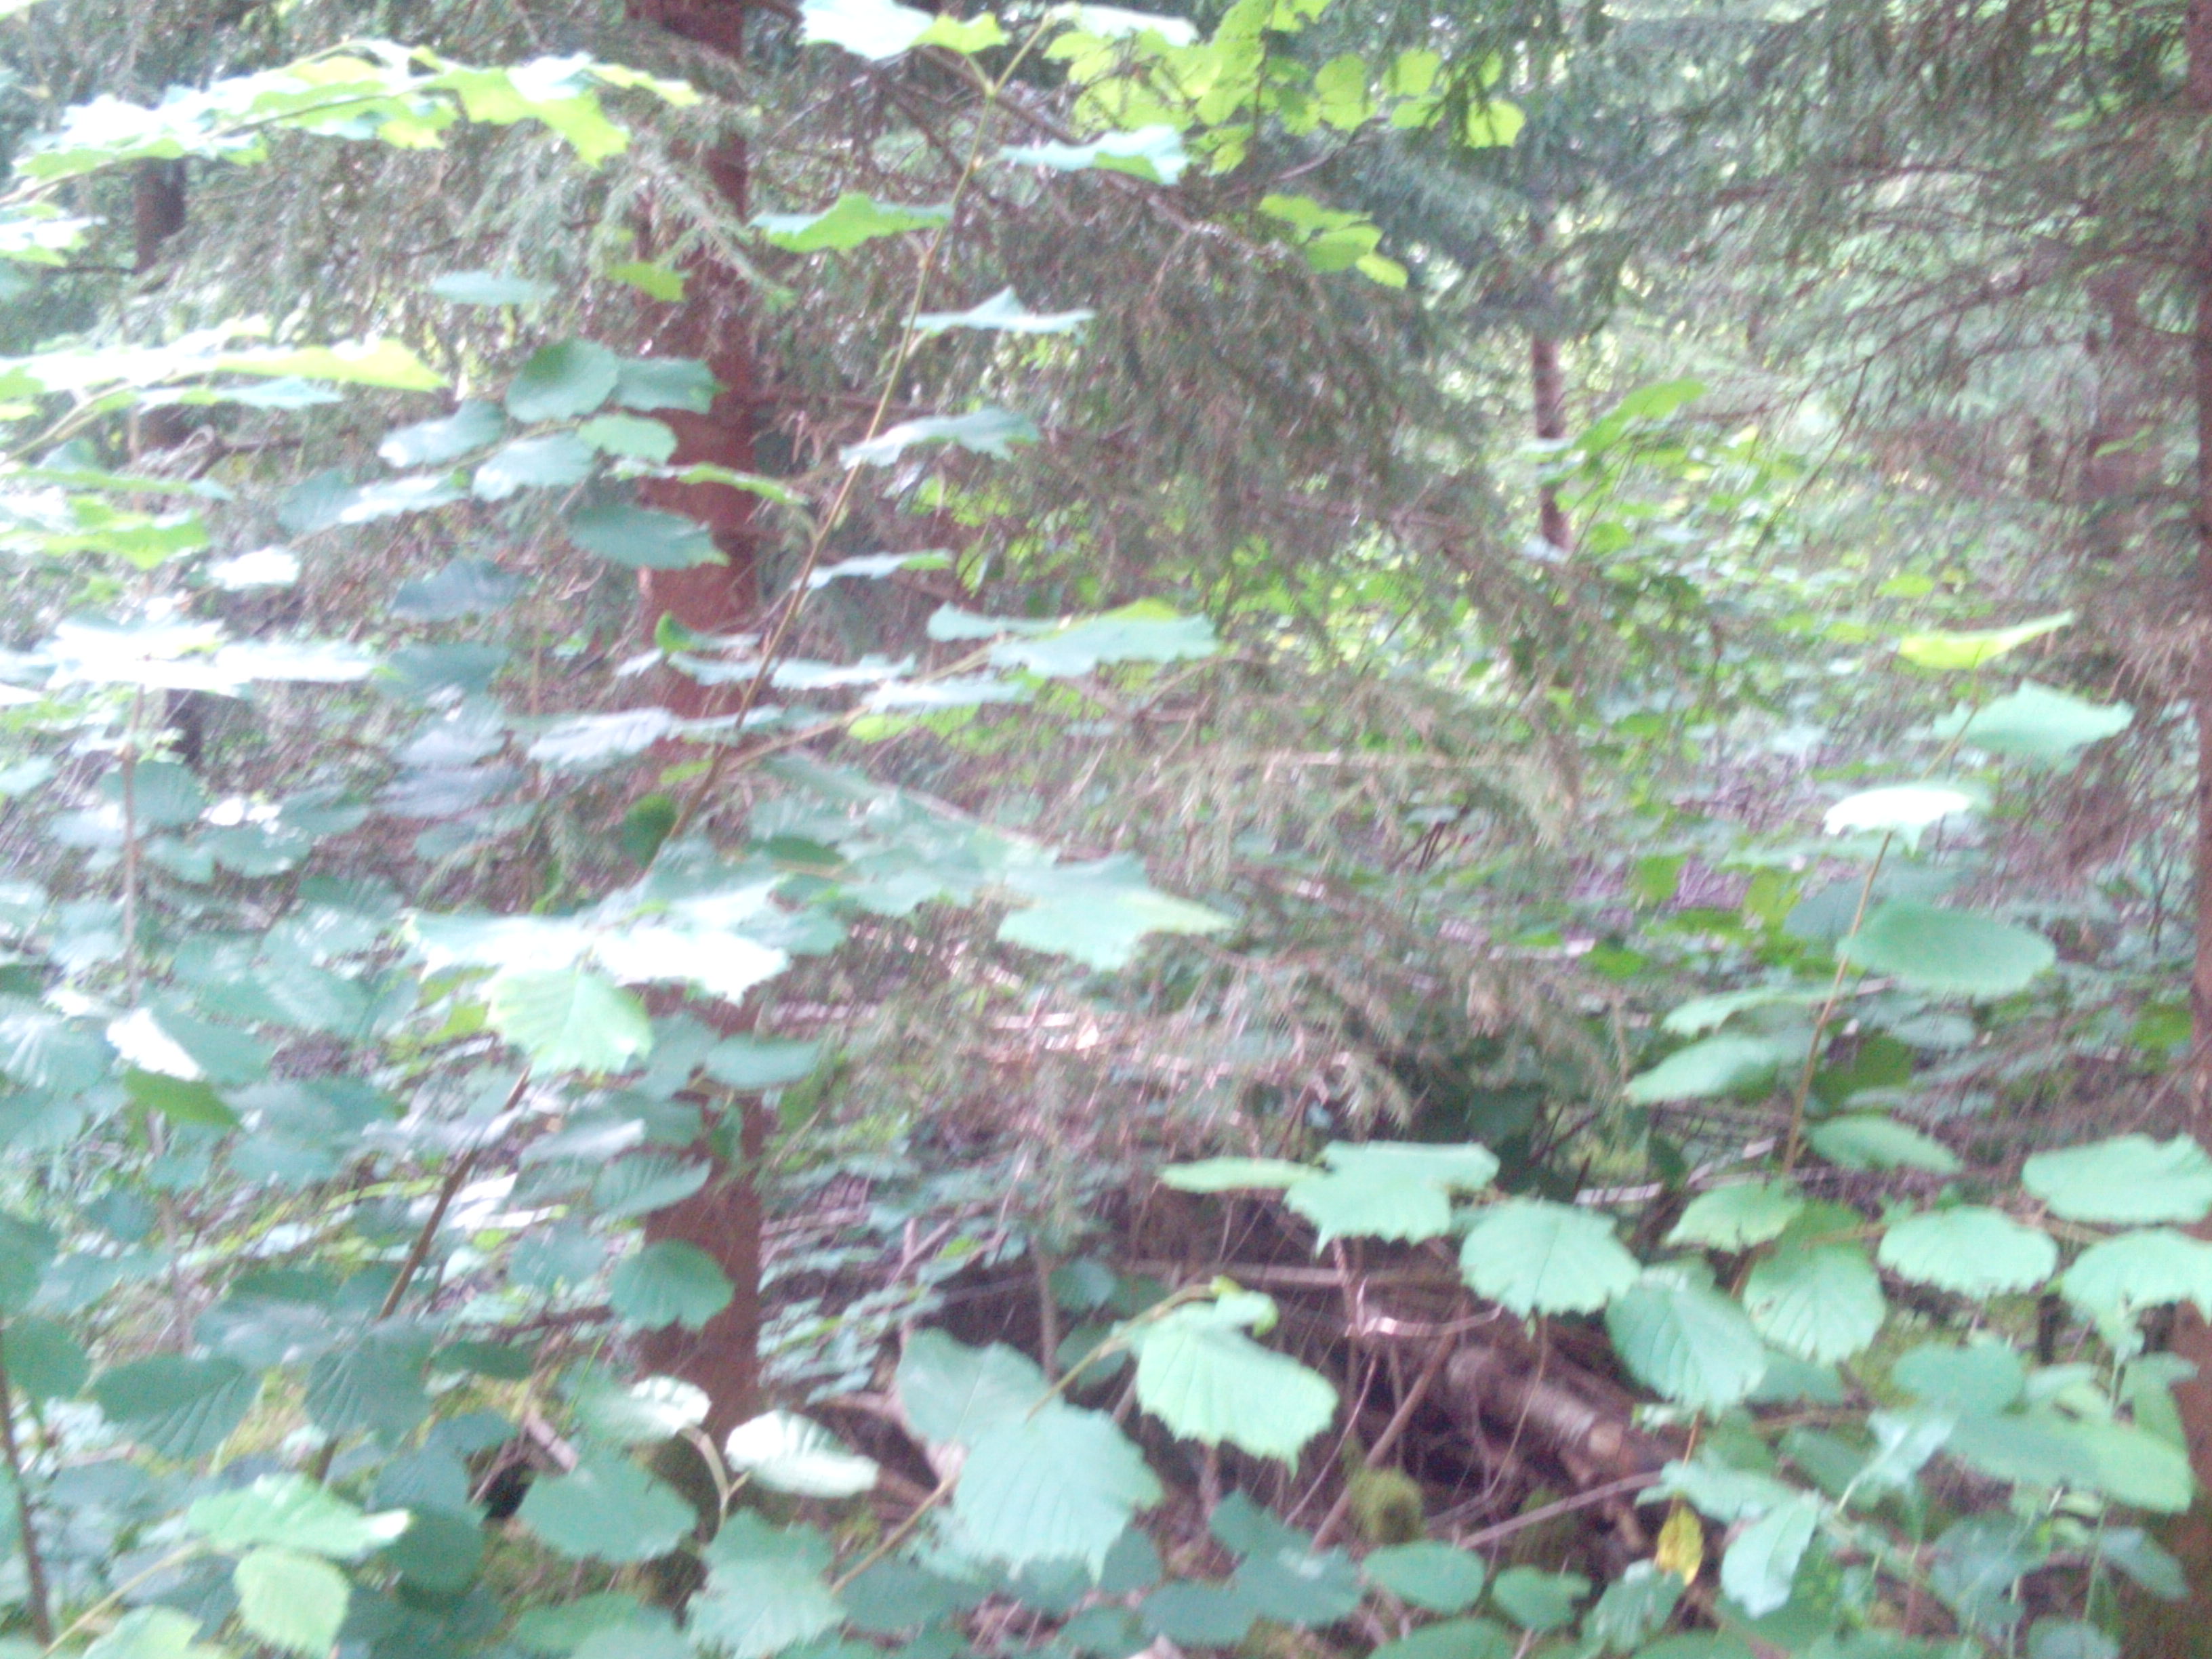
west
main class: Woodland
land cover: Spruce dominated coniferous woodland
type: hemiboreal forest and nemoral coniferous forest and mixed broadleaved-coniferous forest
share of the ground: 50 - 75 %
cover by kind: coniferous forest trees 65 %, herbaceous plants 20 %, broadleaved forest trees 15 %
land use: Forestry
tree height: > 5 m
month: July
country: LV
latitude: 56.6140
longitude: 21.2984
